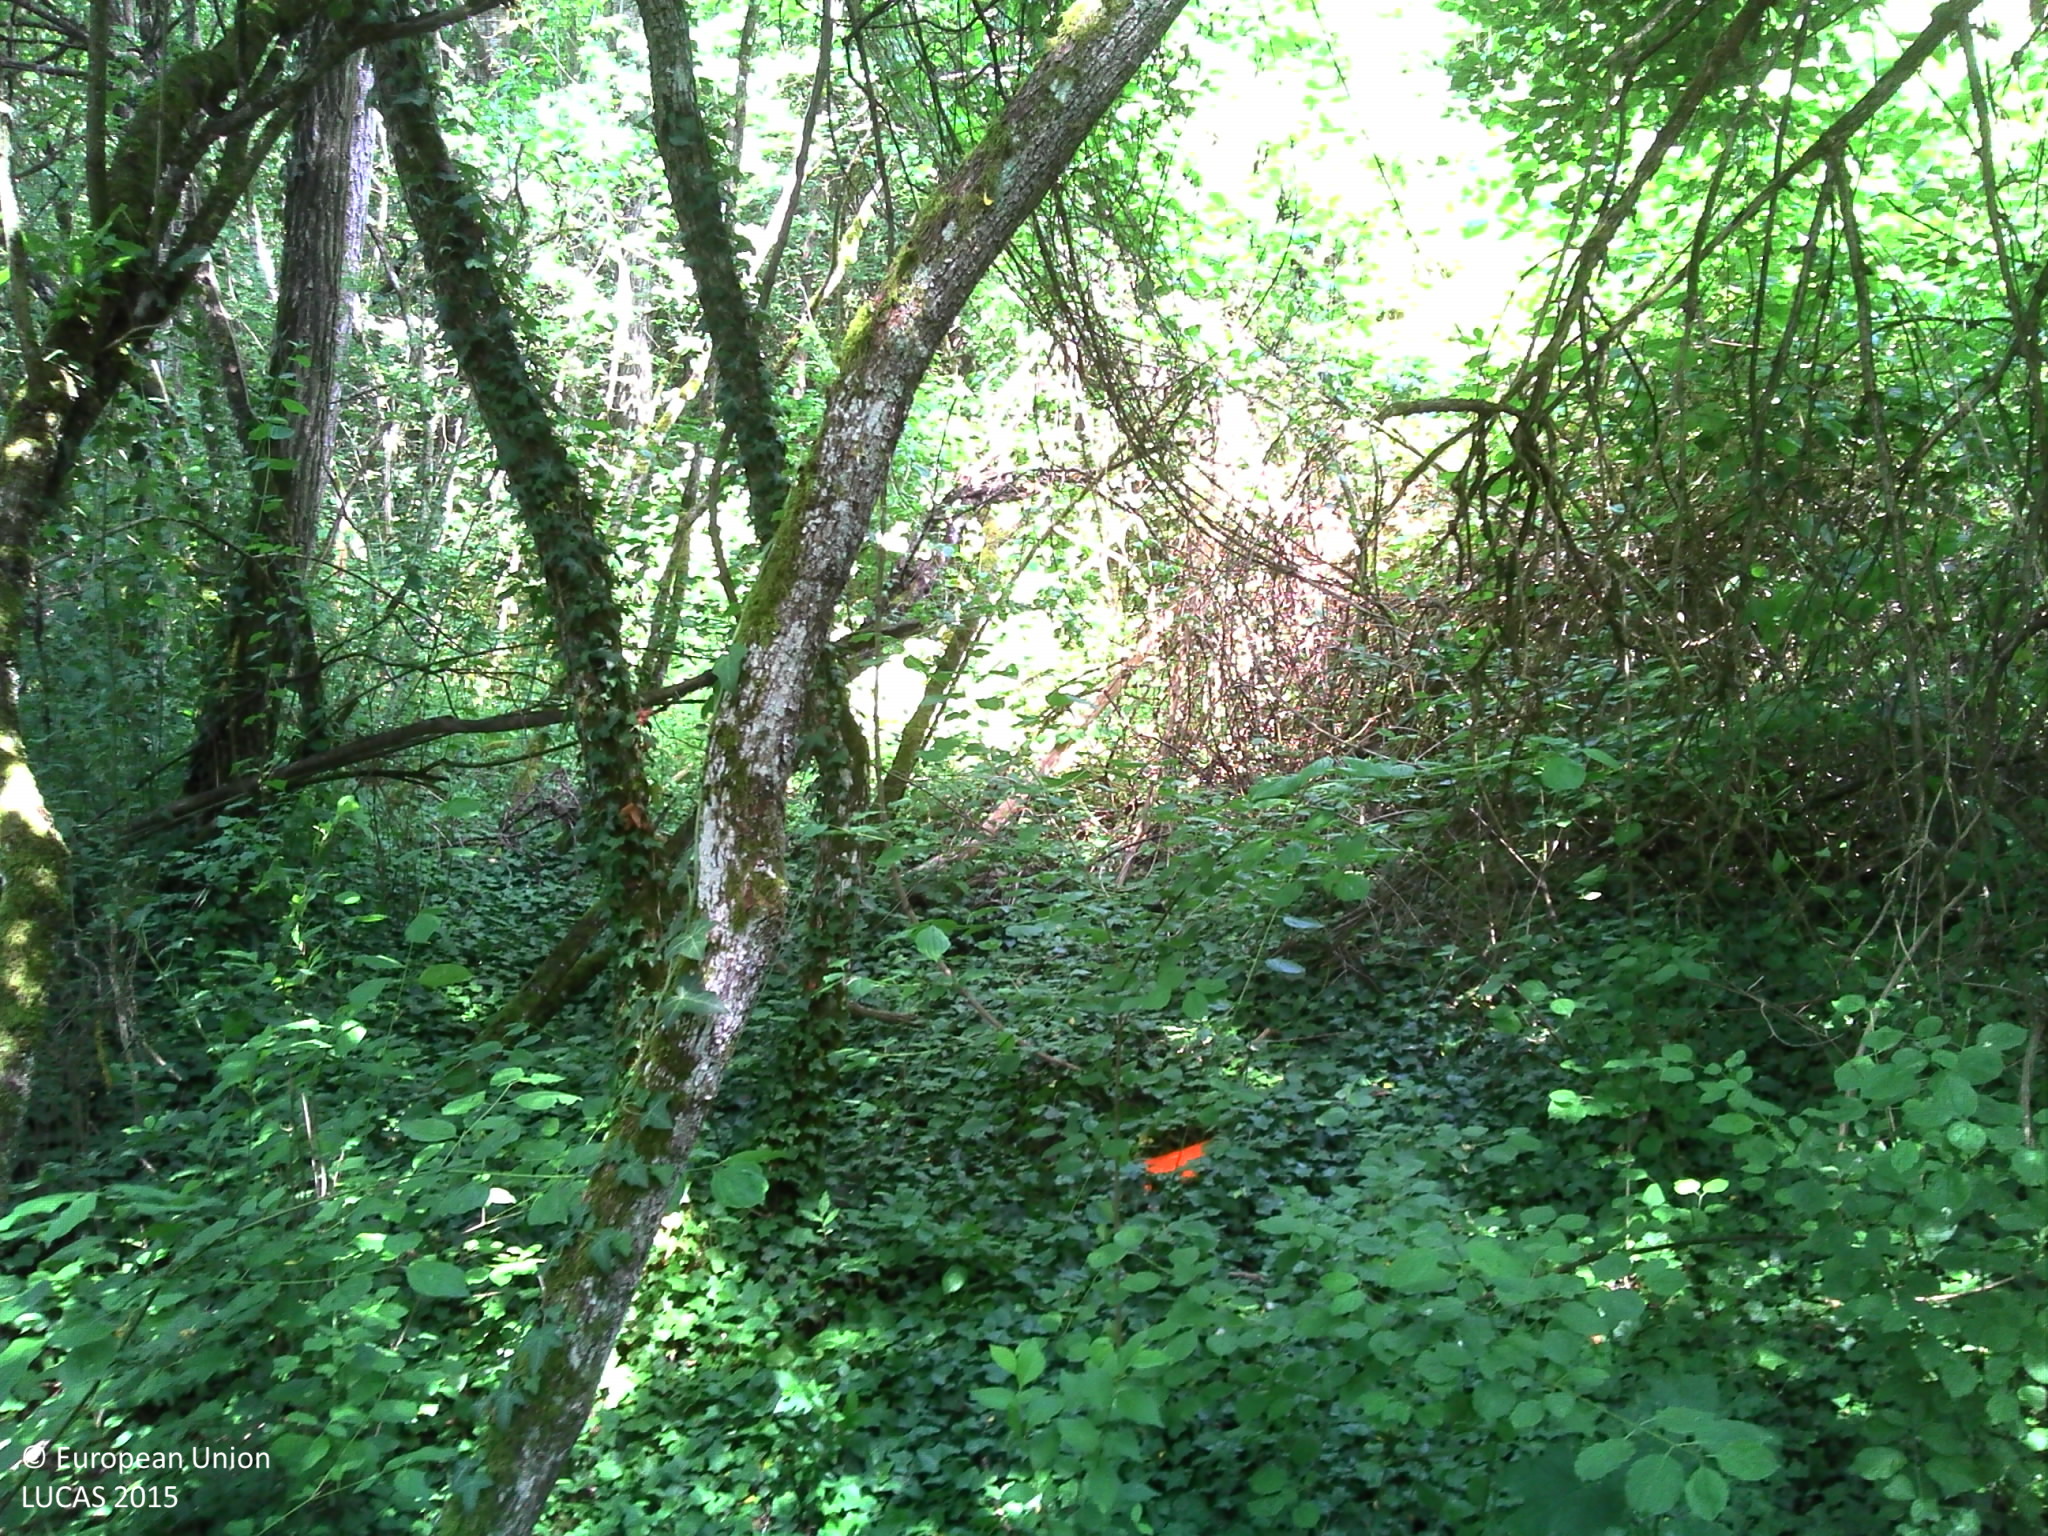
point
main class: Woodland
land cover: Broadleaved woodland
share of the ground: > 75 %
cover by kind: broadleaved forest trees 90 %, herbaceous plants 5 %, lichens and mosses 5 %
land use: Semi-natural and natural areas not in use
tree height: < 5 m
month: July
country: FR
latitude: 48.6712
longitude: 5.9395
